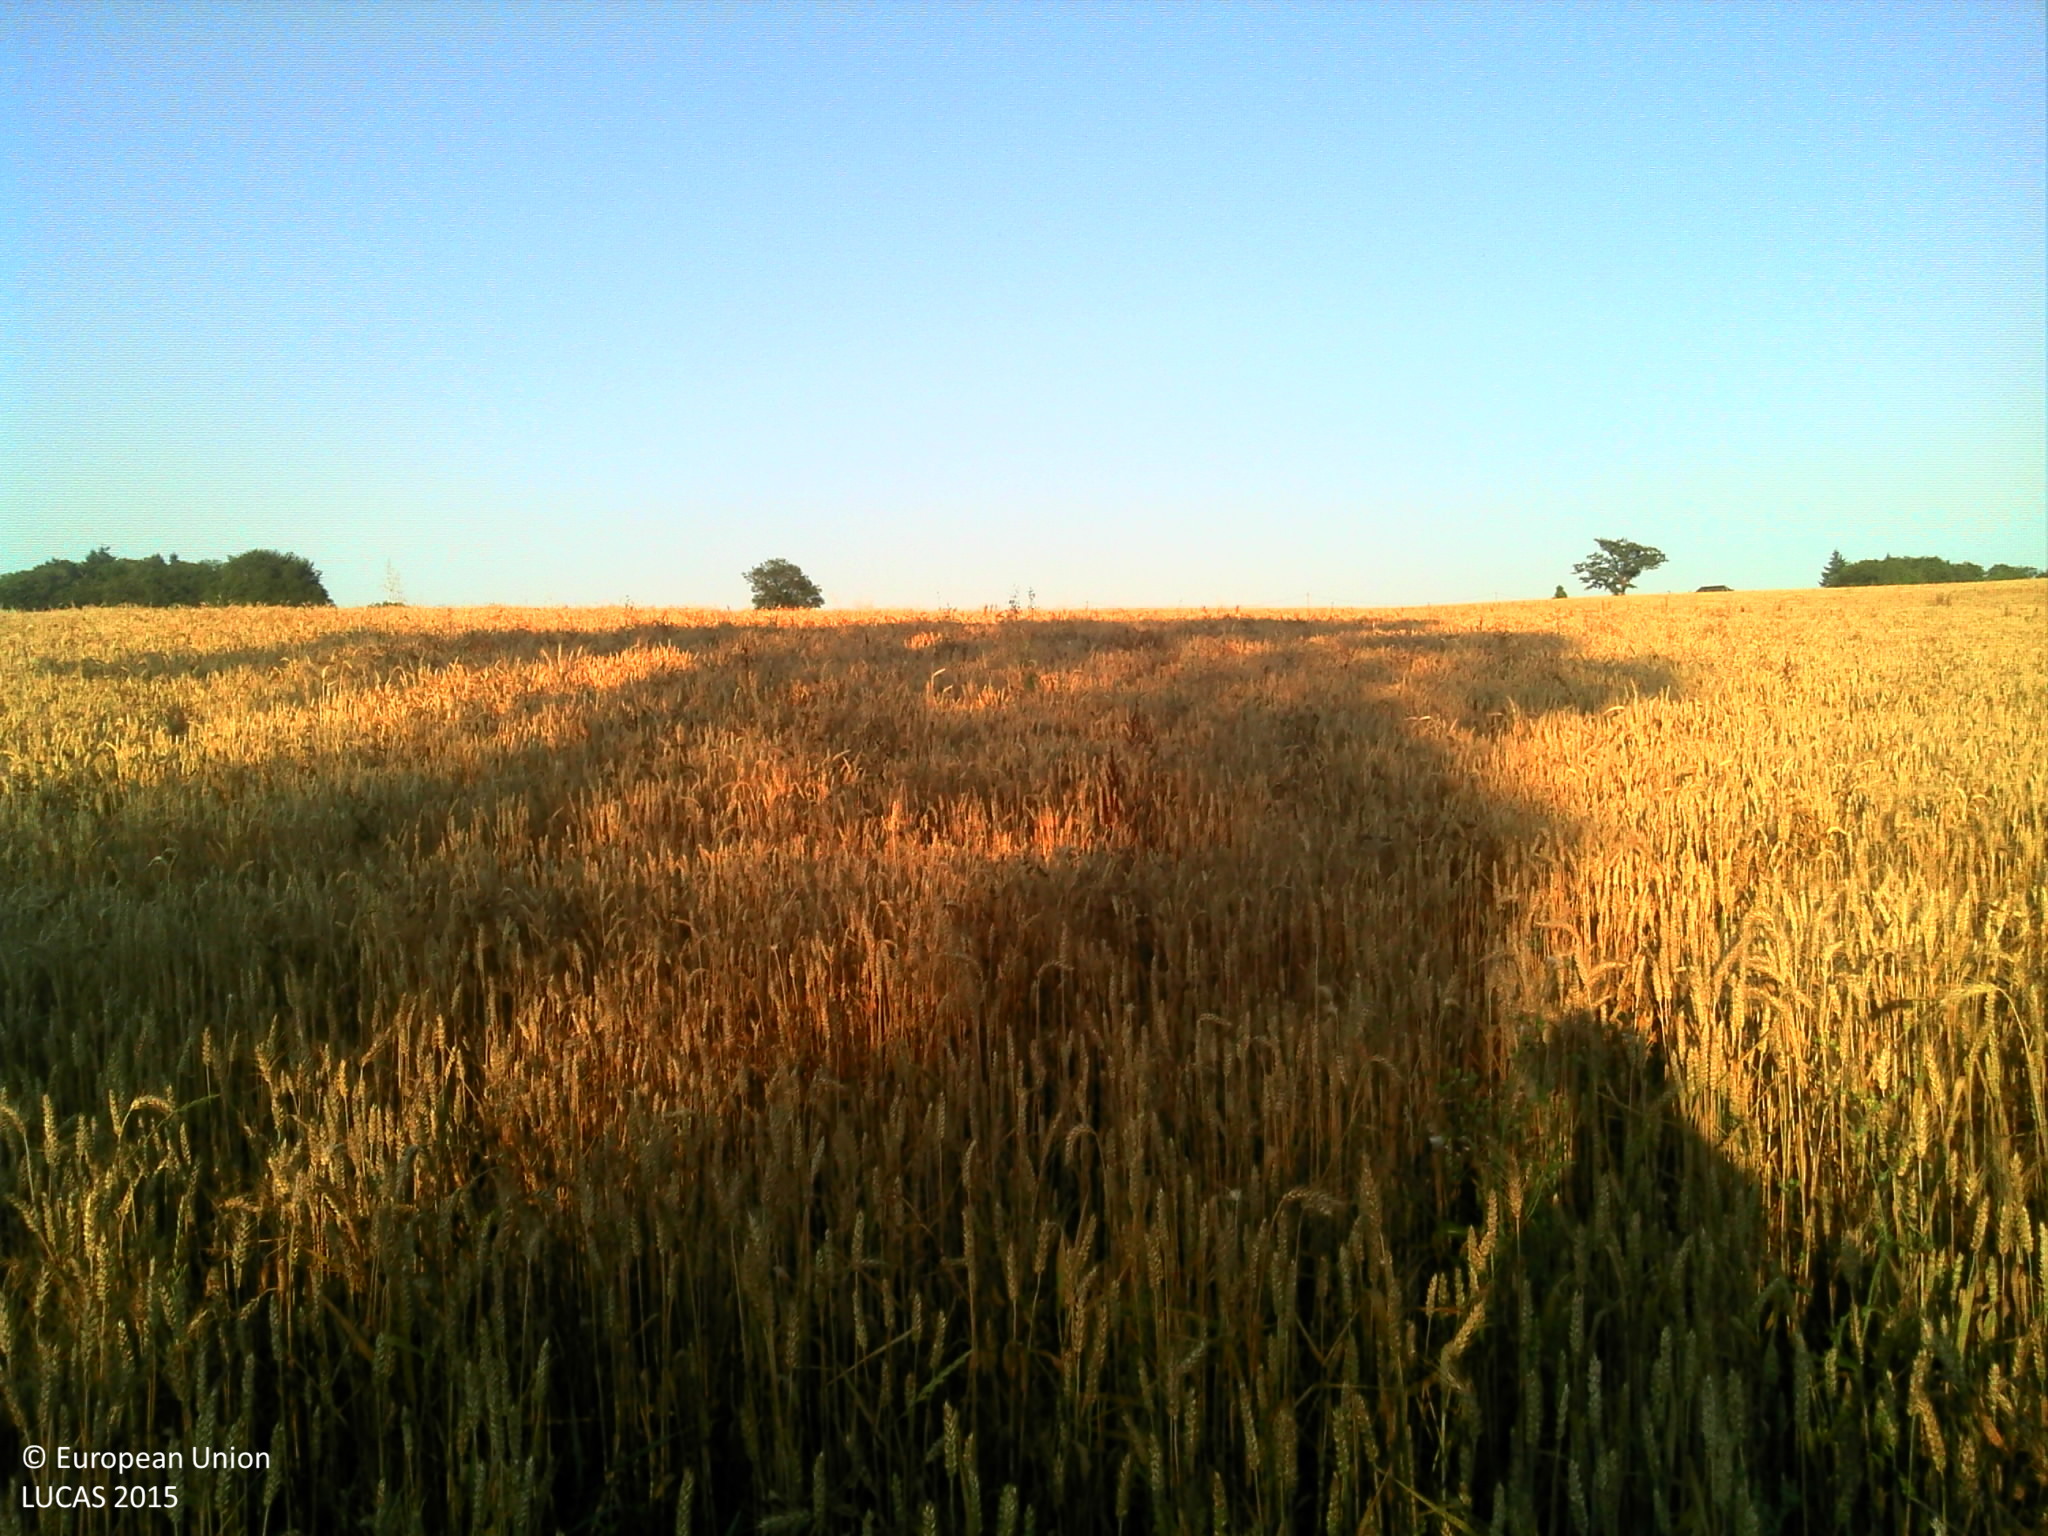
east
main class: Cropland
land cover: Common wheat
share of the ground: > 75 %
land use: Agriculture (excluding fallow land and kitchen gardens)
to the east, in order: Common wheat
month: July
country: FR
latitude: 46.0848
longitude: 1.7289
